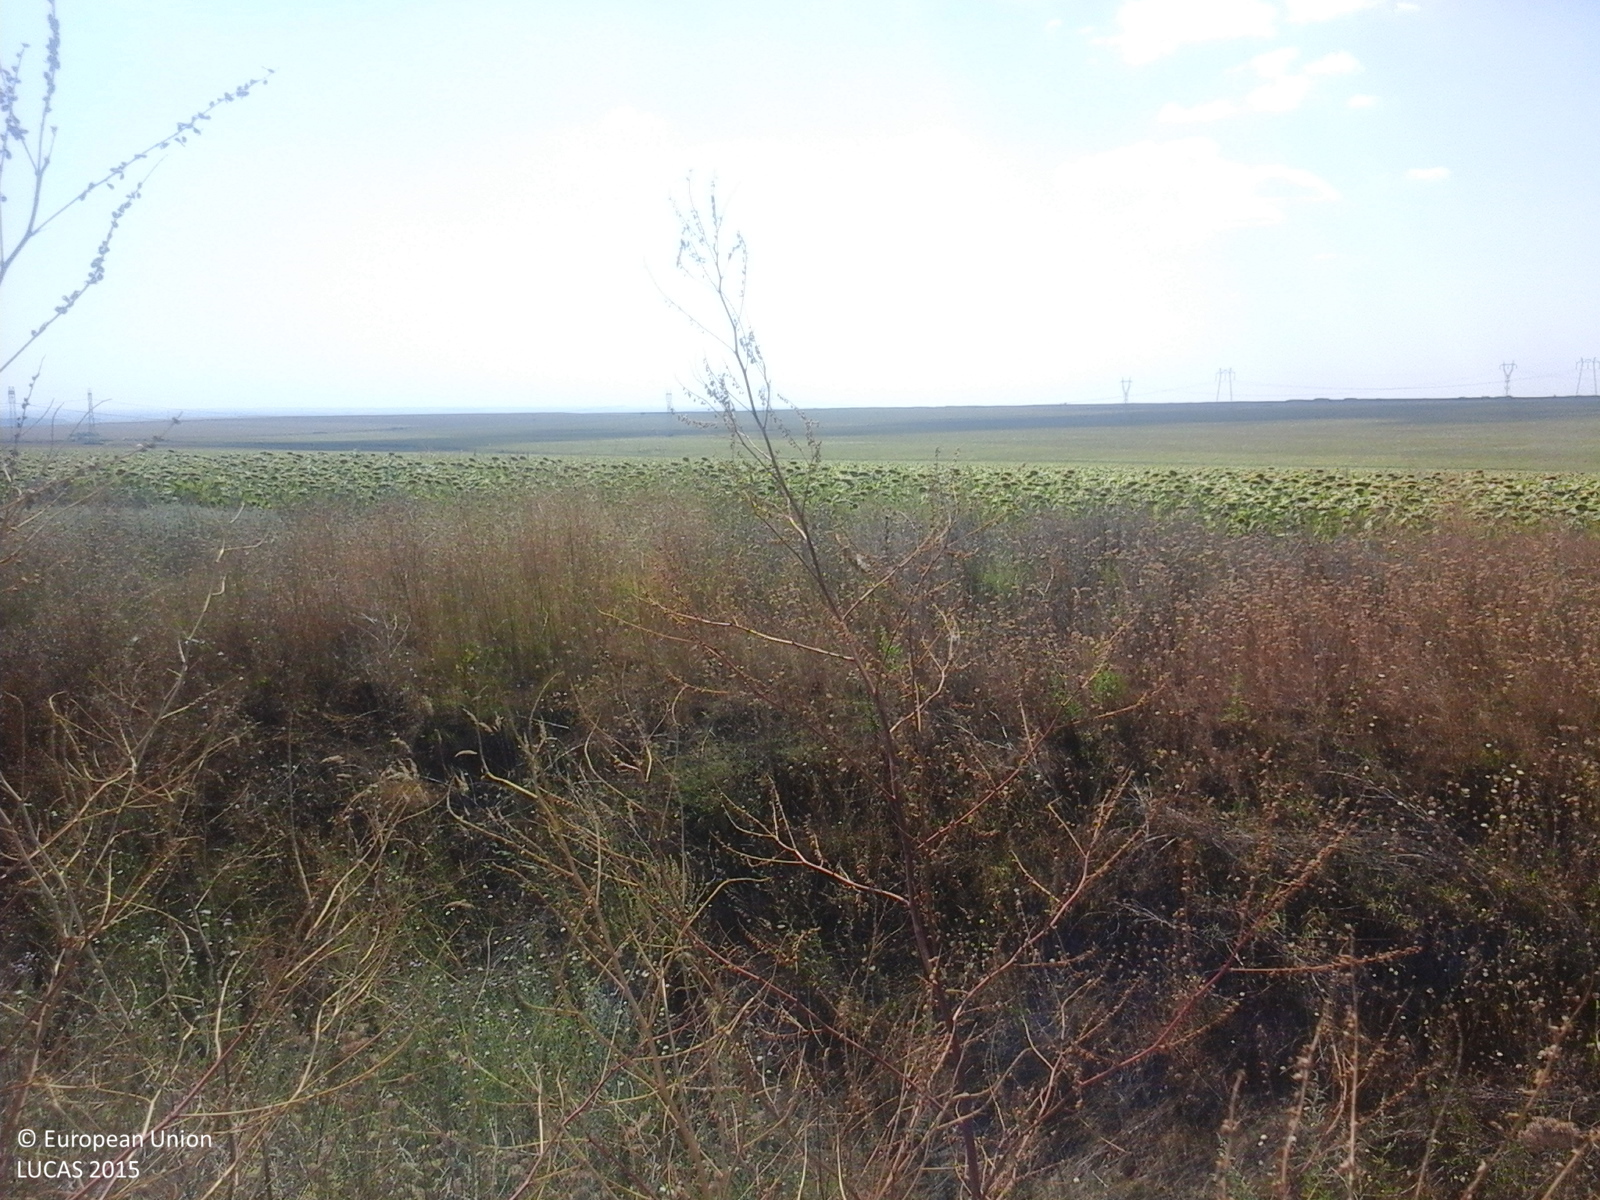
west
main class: Cropland
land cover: Sunflower
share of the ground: > 75 %
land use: Agriculture (excluding fallow land and kitchen gardens)
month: August
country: RO
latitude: 44.5027
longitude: 28.1614
